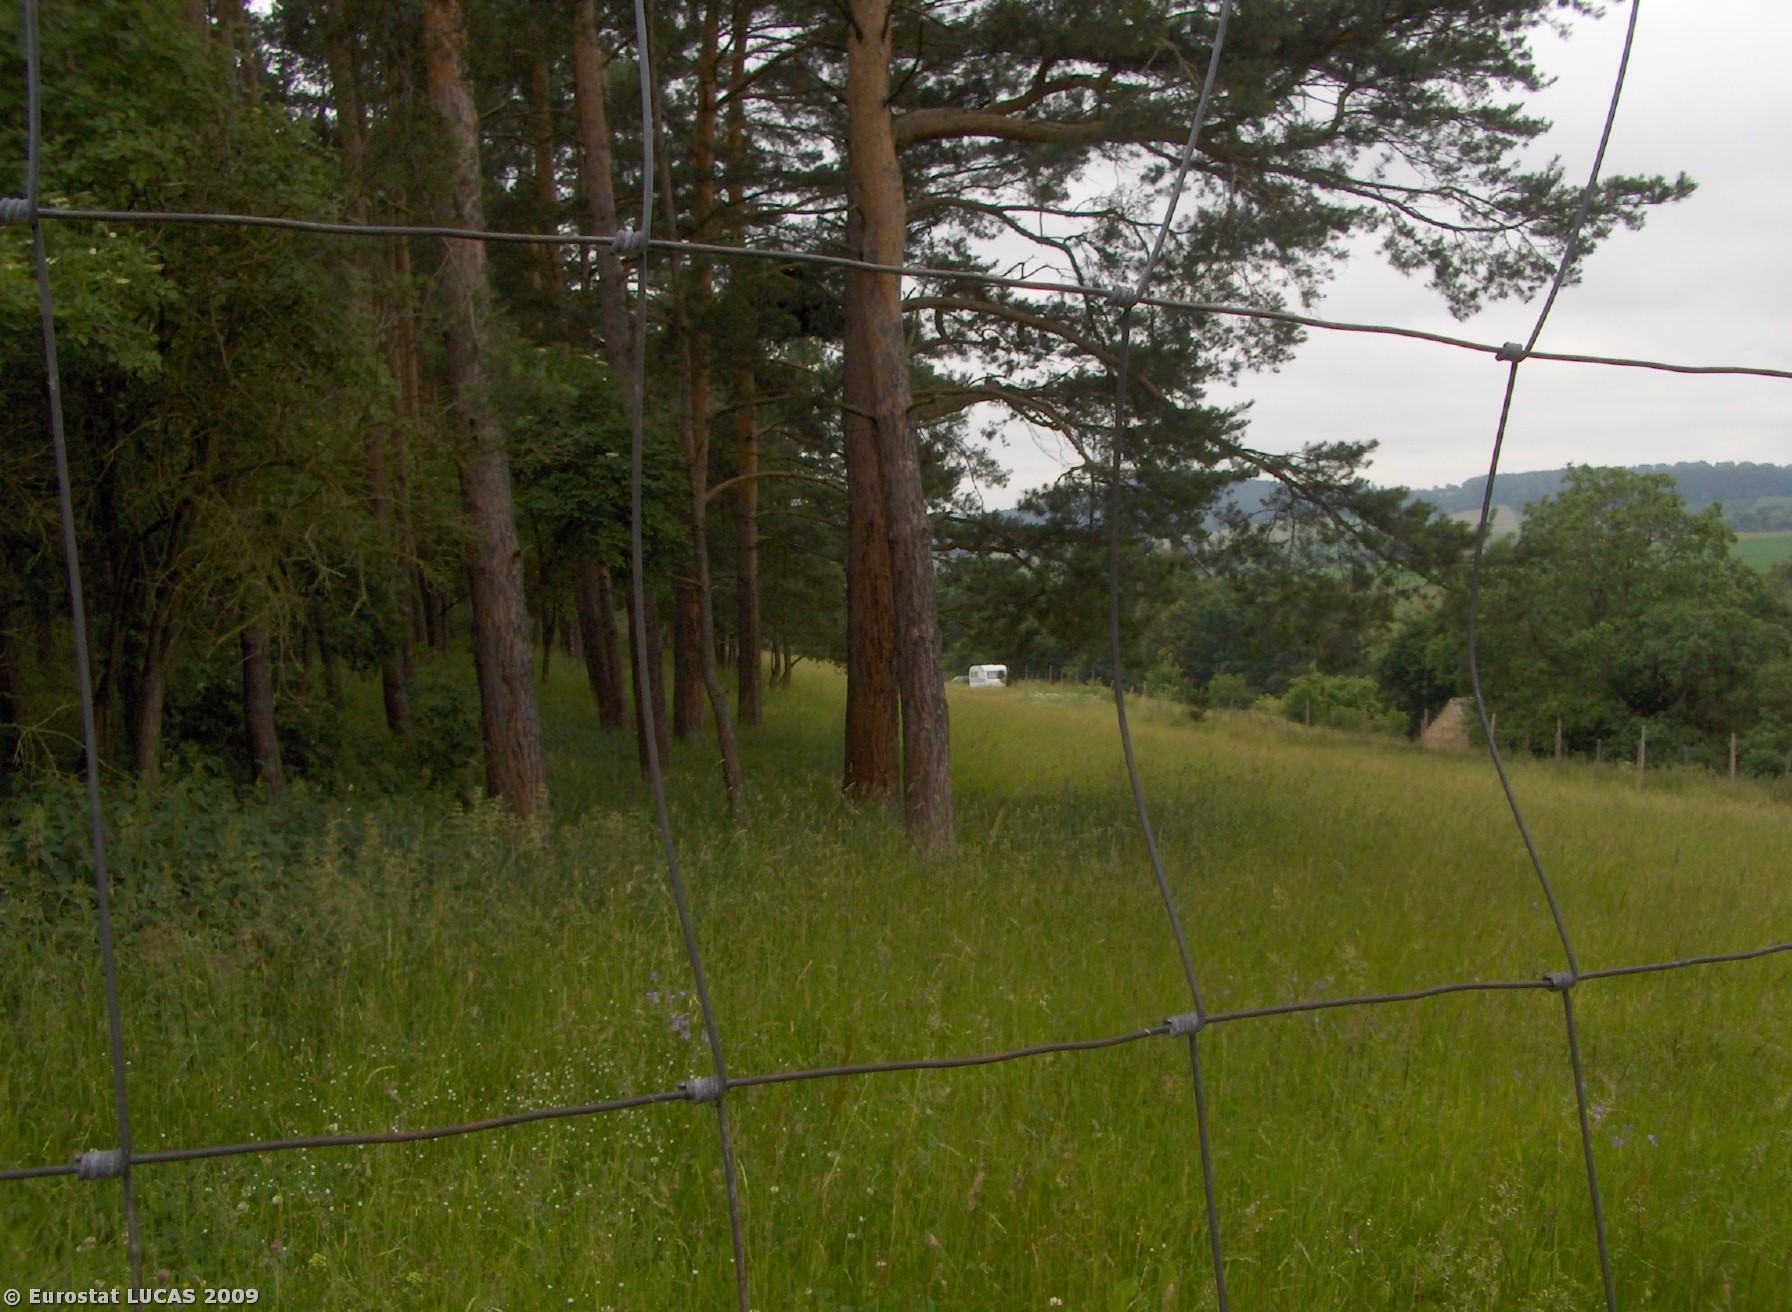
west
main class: Woodland
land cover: Mixed woodland
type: hemiboreal forest and nemoral coniferous forest and mixed broadleaved-coniferous forest
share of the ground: > 75 %
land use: Forestry
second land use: Agriculture (excluding fallow land and kitchen gardens)
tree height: > 5 m
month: June
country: CZ
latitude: 49.7761
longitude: 14.3756
